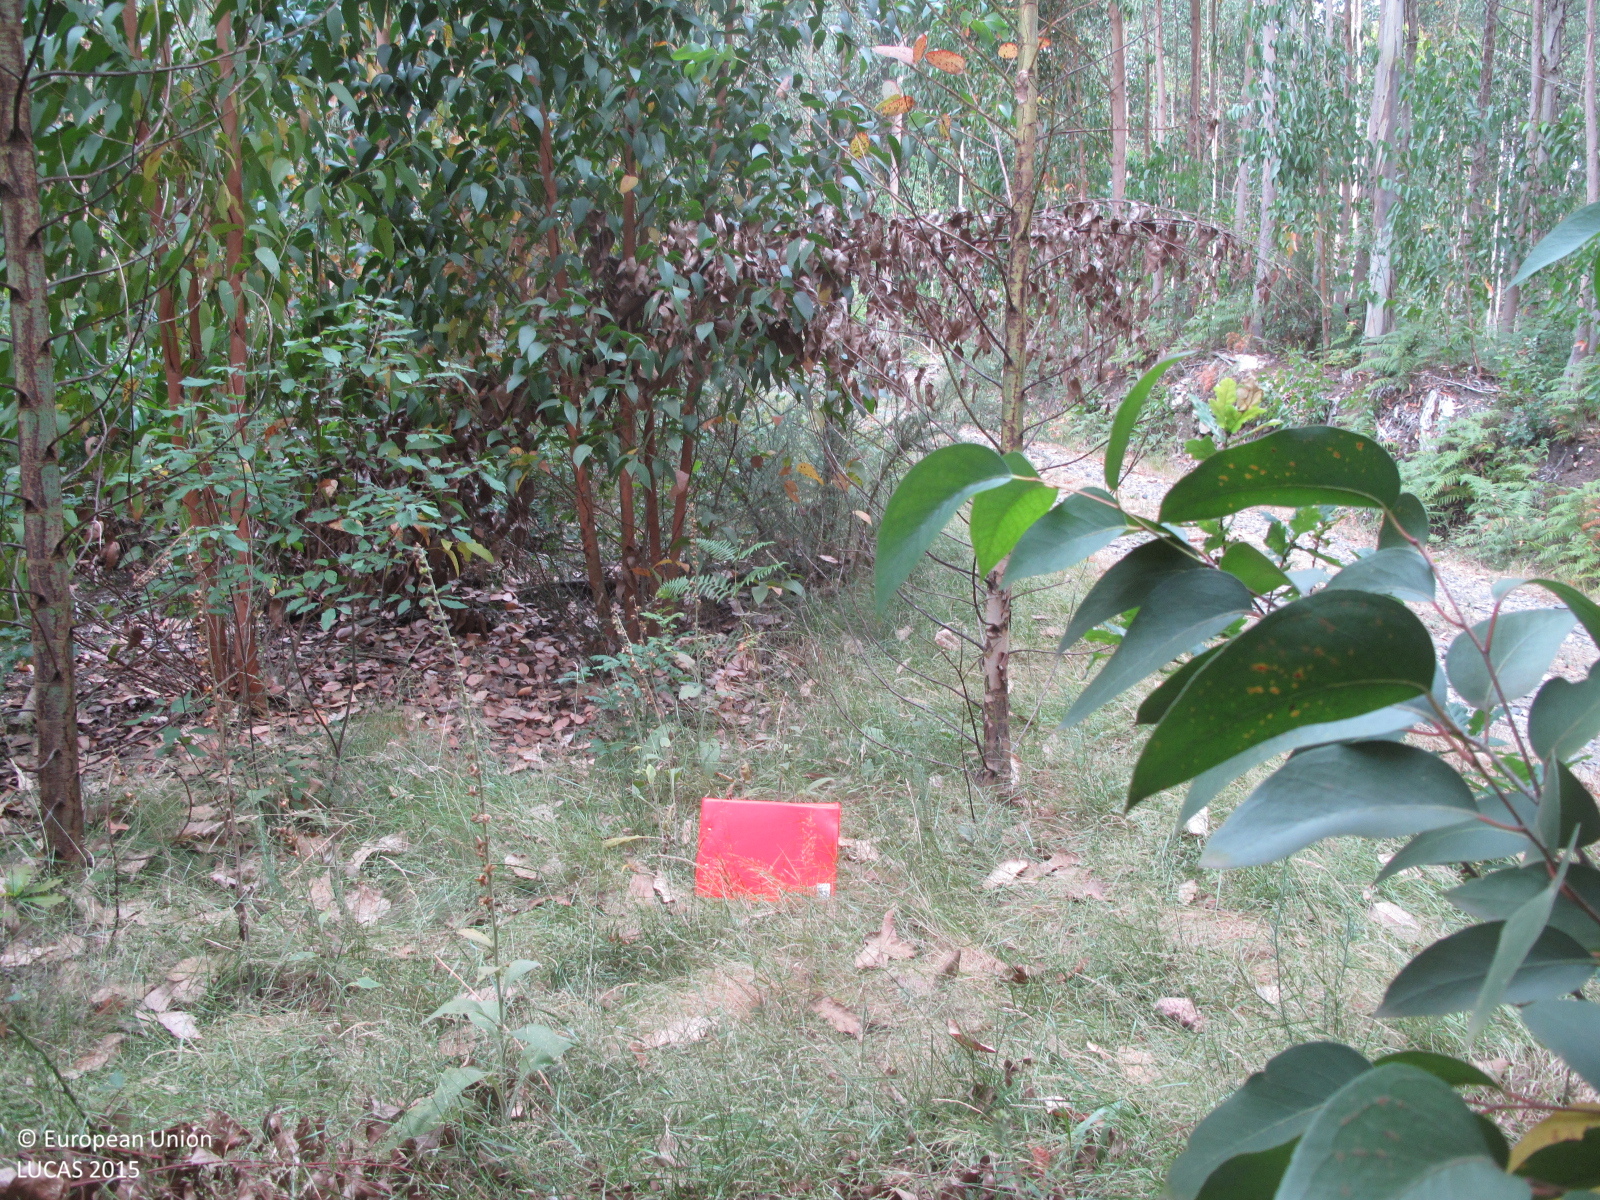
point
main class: Woodland
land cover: Broadleaved woodland
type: exotic forest
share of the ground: 50 - 75 %
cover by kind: broadleaved forest trees 60 %, herbaceous plants 20 %, shrubs 10 %, unconsolidated bare surface 10 %
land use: Forestry
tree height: > 5 m
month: July
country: ES
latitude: 43.2645
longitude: -8.0697
